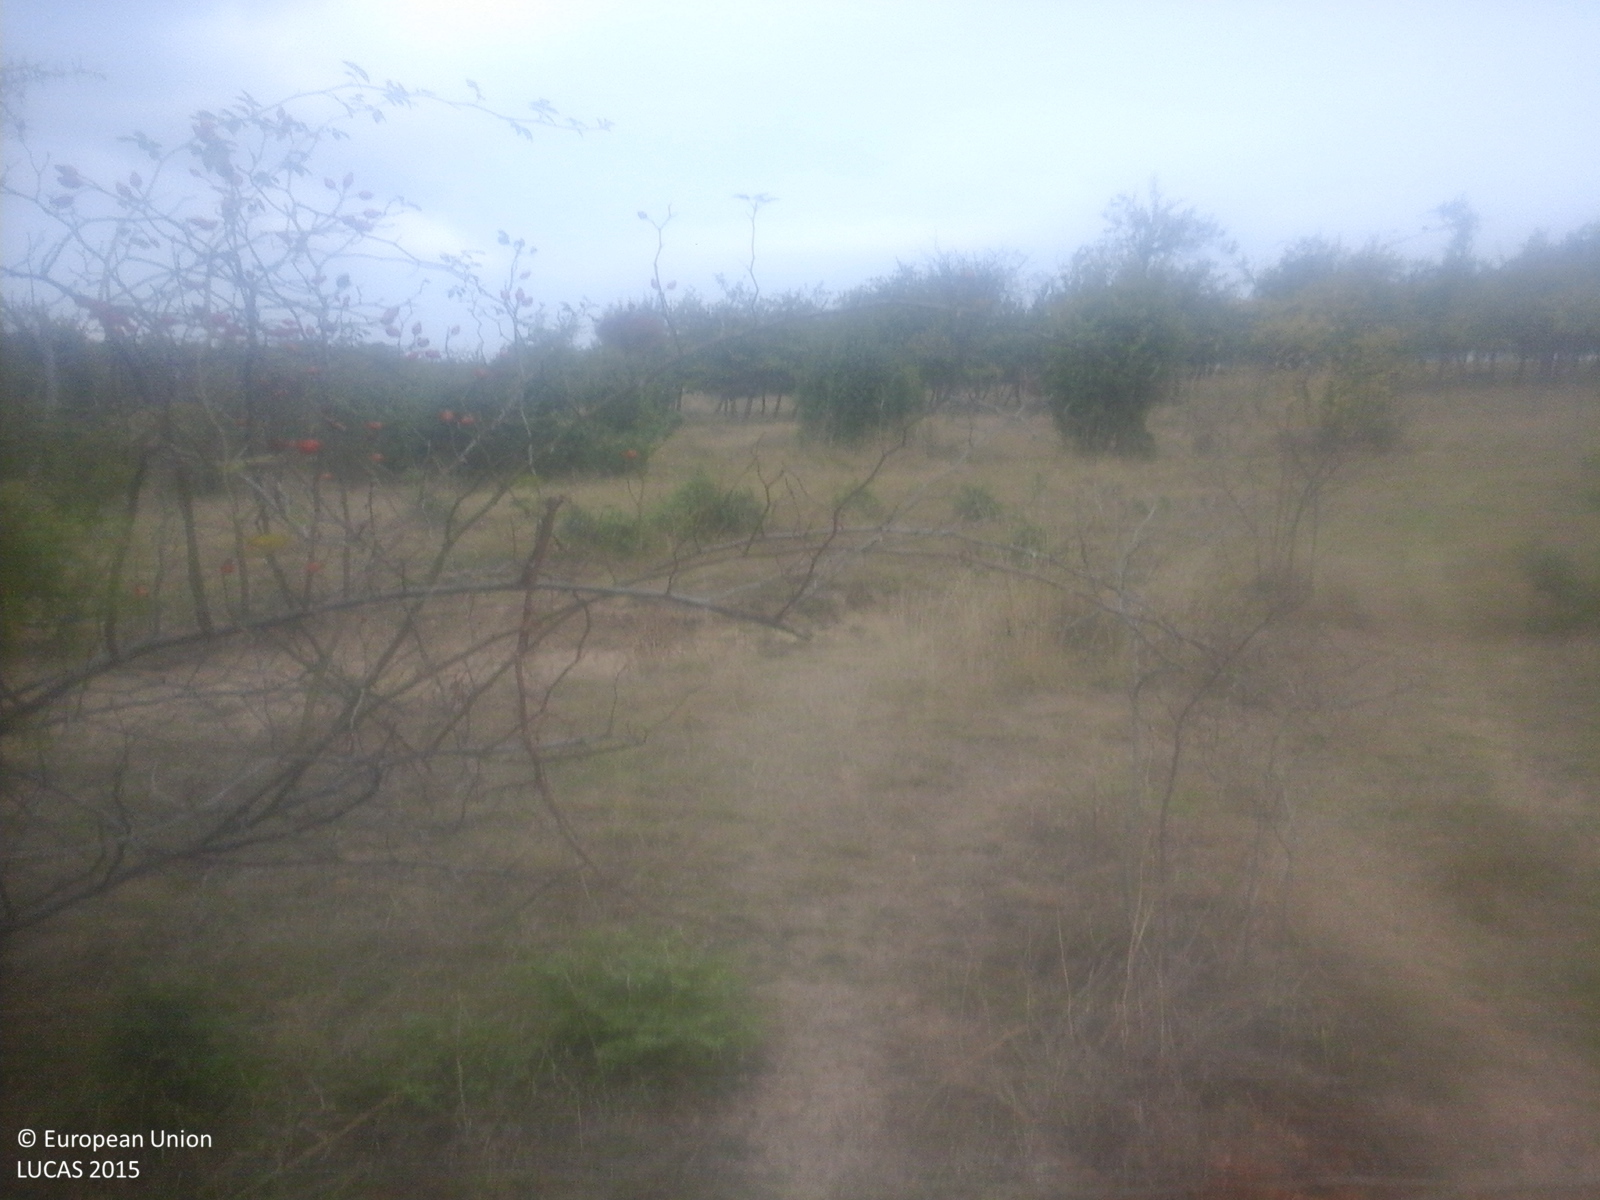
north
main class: Shrubland
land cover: Shrubland with sparse tree cover
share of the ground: > 75 %
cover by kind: shrubs 60 %, herbaceous plants 35 %, coniferous forest trees 5 %
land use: Forestry
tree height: < 5 m
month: September
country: RO
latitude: 45.4254
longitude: 21.9361
